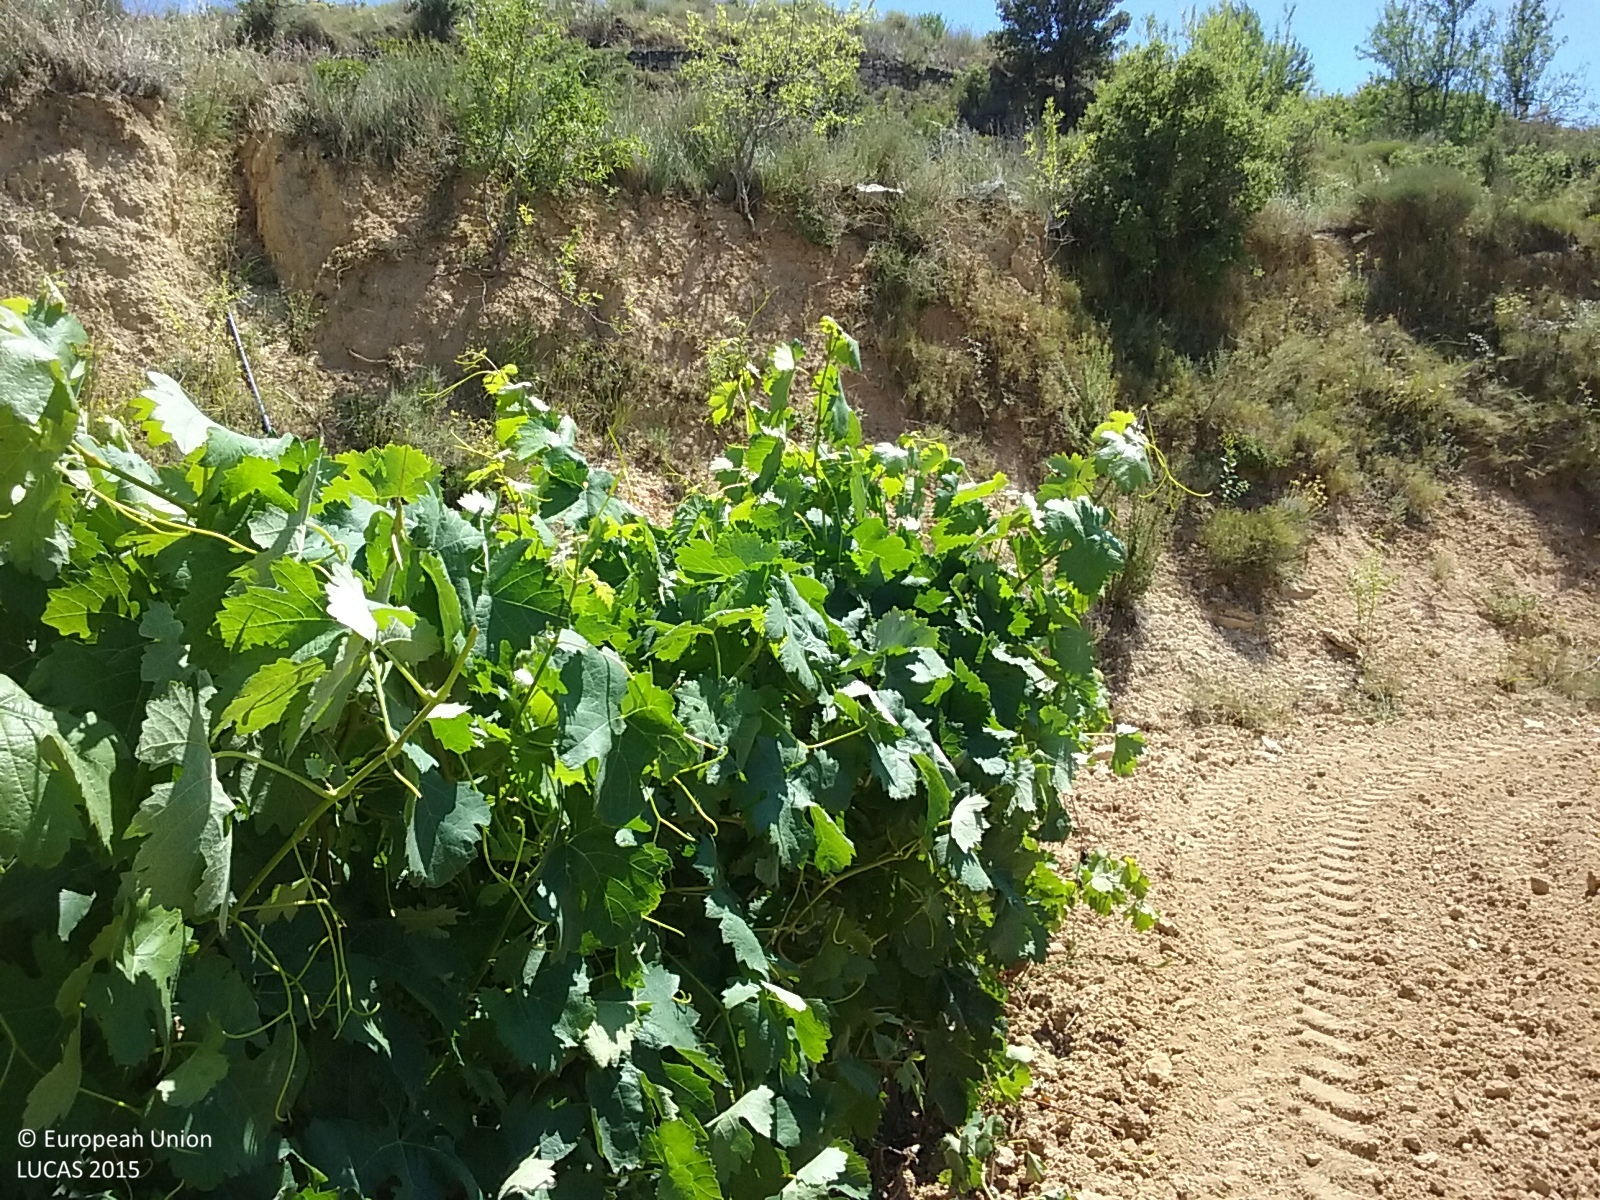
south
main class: Cropland
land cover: Vineyards
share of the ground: 10 - 25 %
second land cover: Other bare soil
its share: > 75 %
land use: Agriculture (excluding fallow land and kitchen gardens)
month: June
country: ES
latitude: 41.0996
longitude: 0.3344
